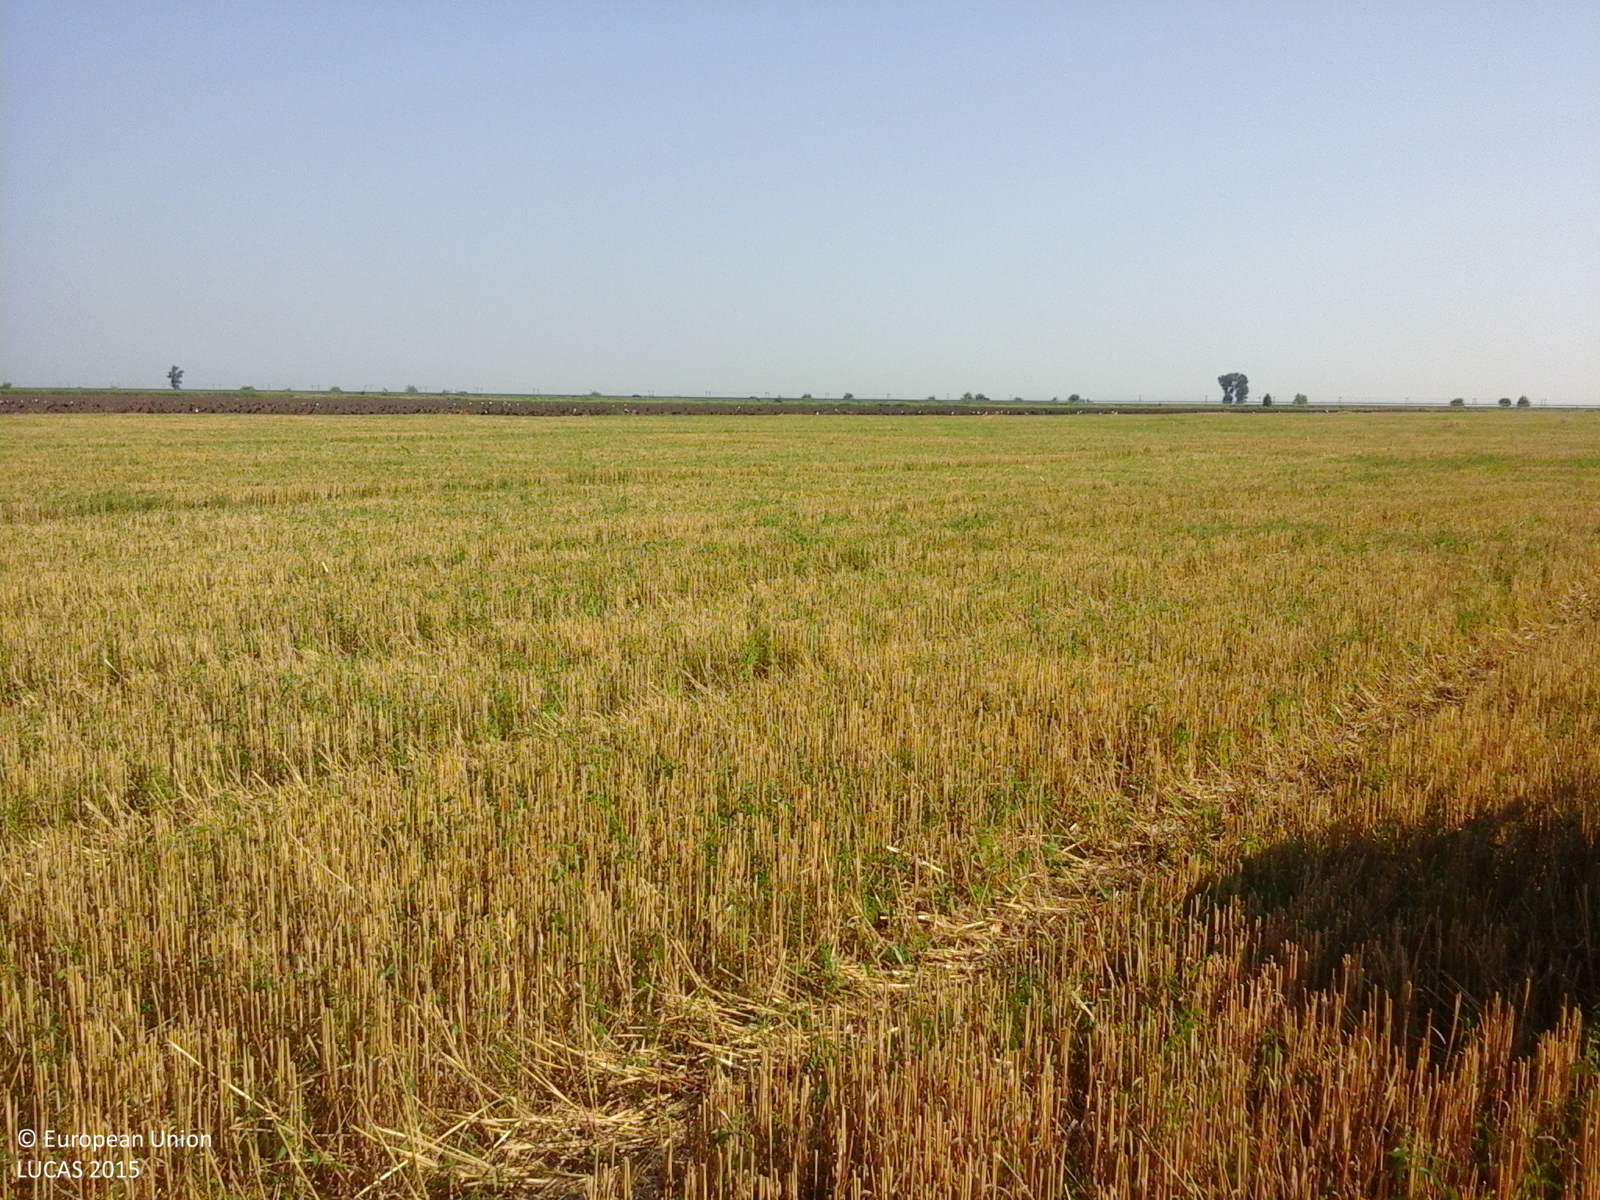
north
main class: Cropland
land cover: Common wheat
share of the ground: > 75 %
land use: Agriculture (excluding fallow land and kitchen gardens)
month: July
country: RO
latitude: 44.4220
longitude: 27.0221
